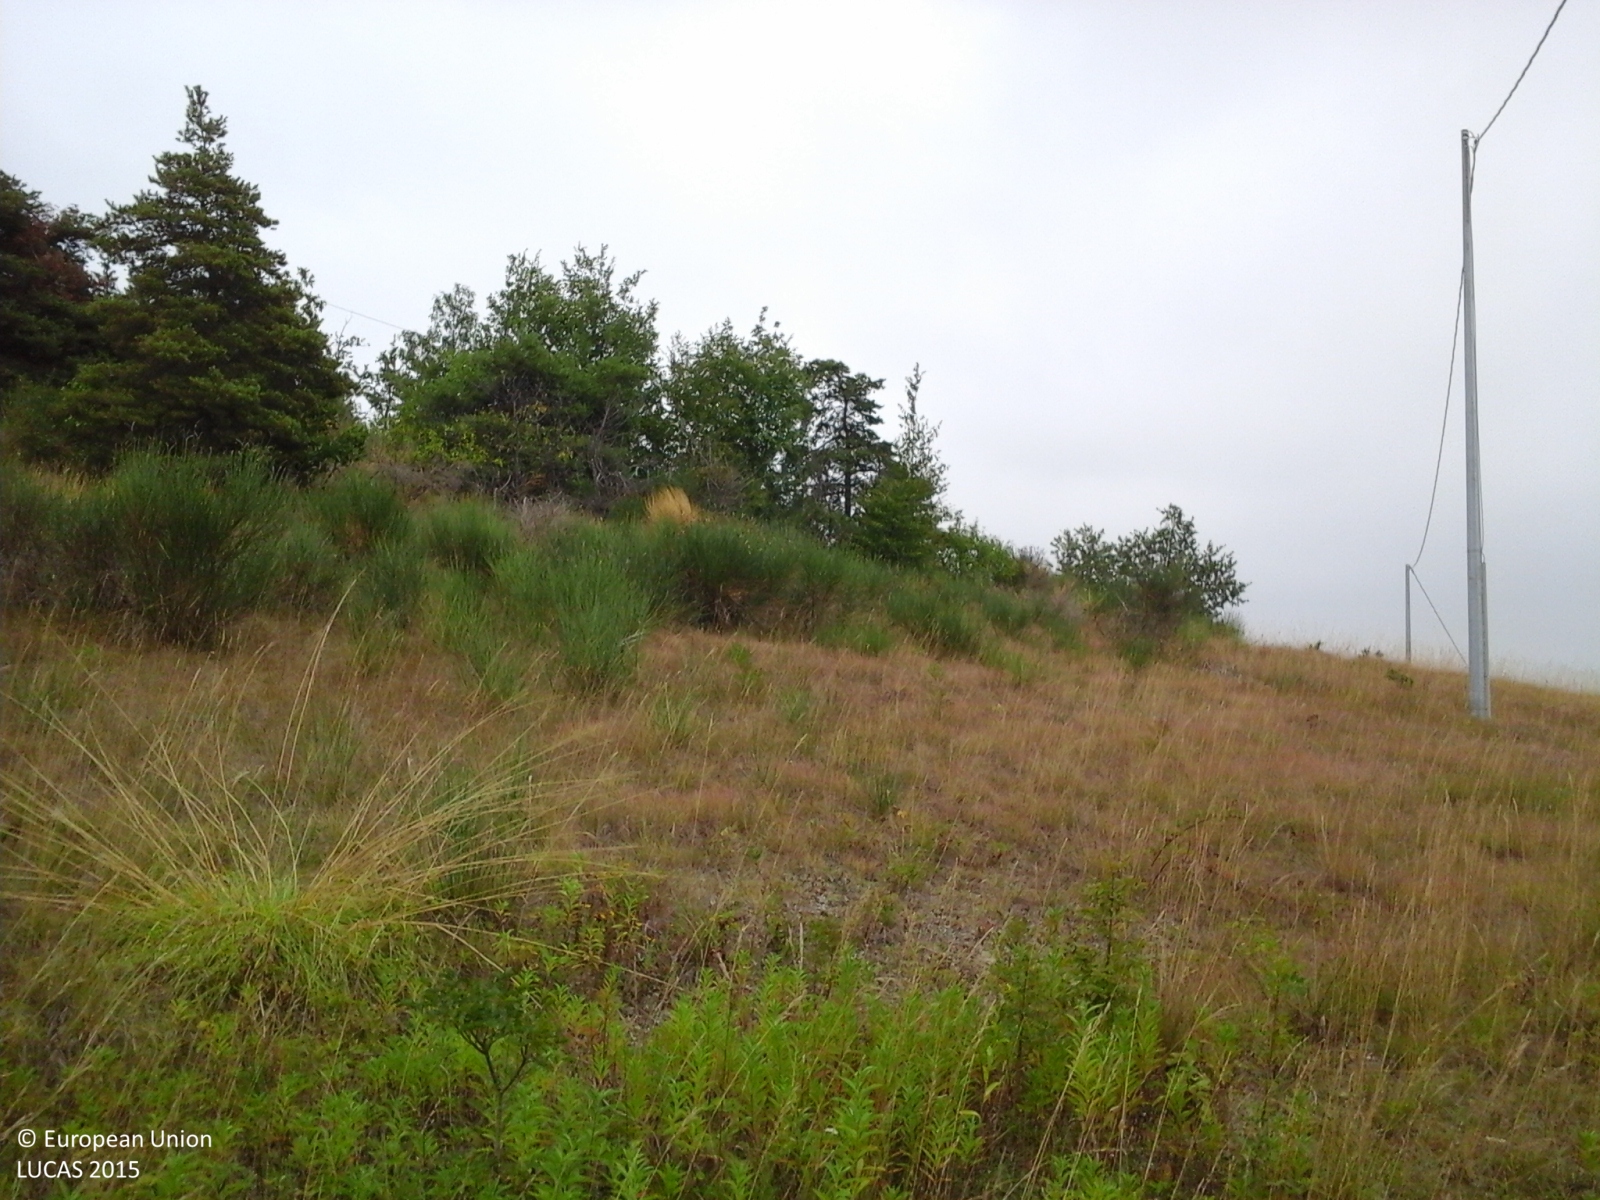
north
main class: Grassland
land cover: Grassland with sparse tree/shrub cover
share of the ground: > 75 %
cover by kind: herbaceous plants 85 %, broadleaved forest trees 5 %, shrubs 5 %, lichens and mosses 5 %
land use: Semi-natural and natural areas not in use
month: July
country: IT
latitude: 44.4806
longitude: 8.2812
